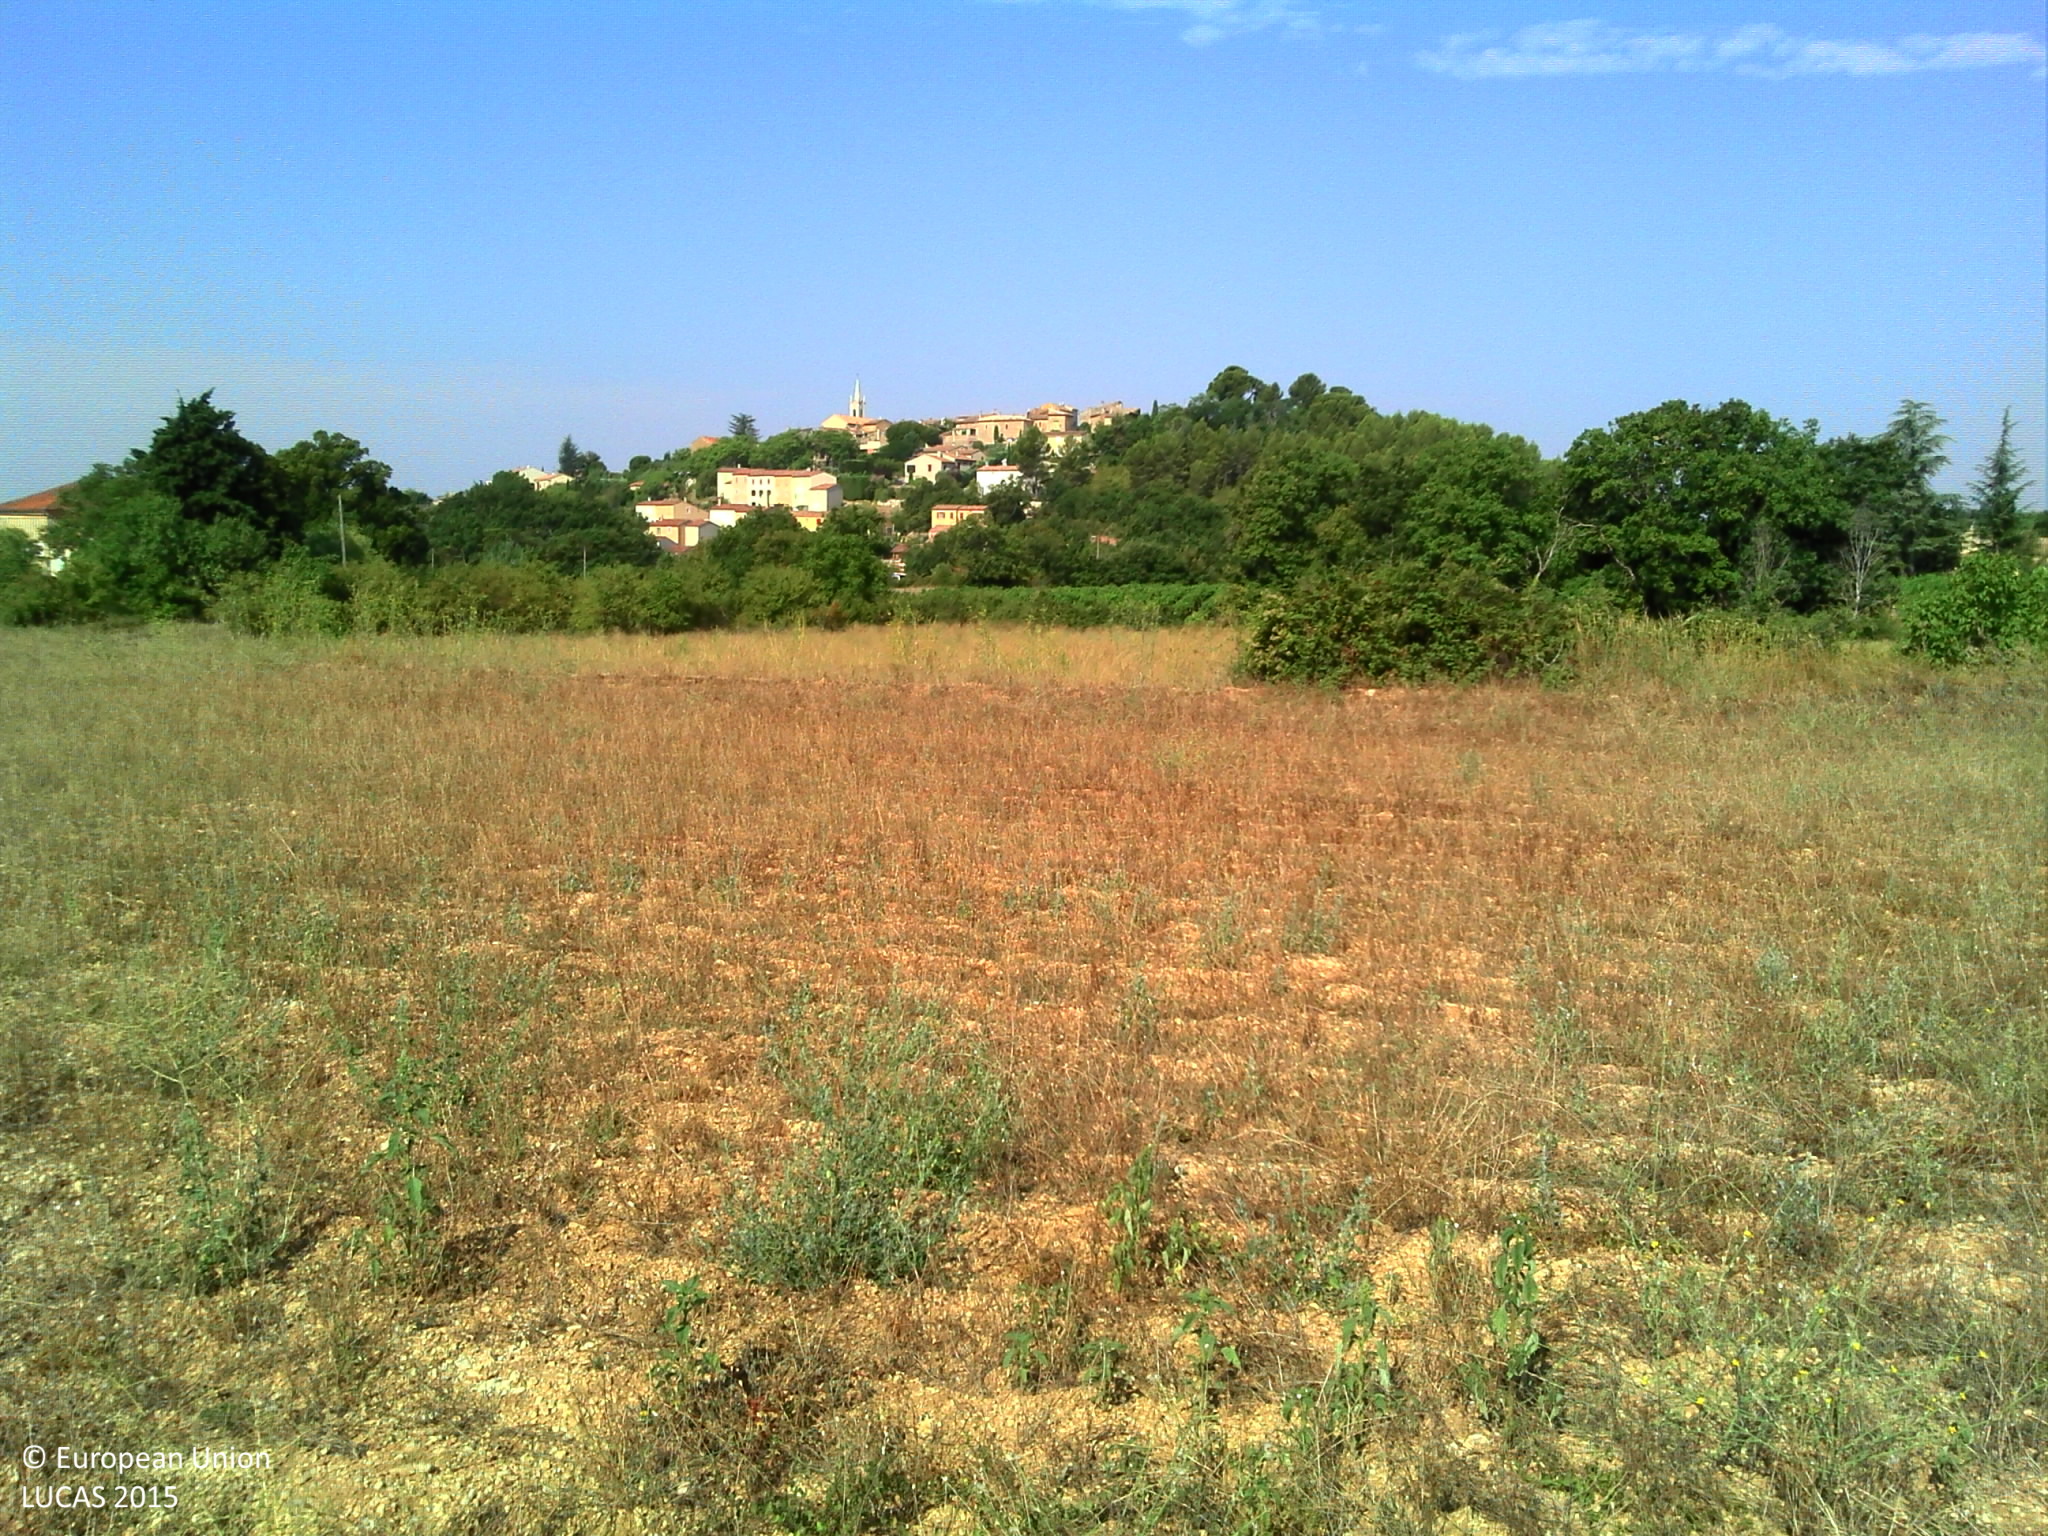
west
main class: Grassland
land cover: Spontaneously vegetated surfaces
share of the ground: > 75 %
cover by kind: herbaceous plants 70 %, unconsolidated bare surface 30 %
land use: Semi-natural and natural areas not in use
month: August
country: FR
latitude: 43.9240
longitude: 5.4127
